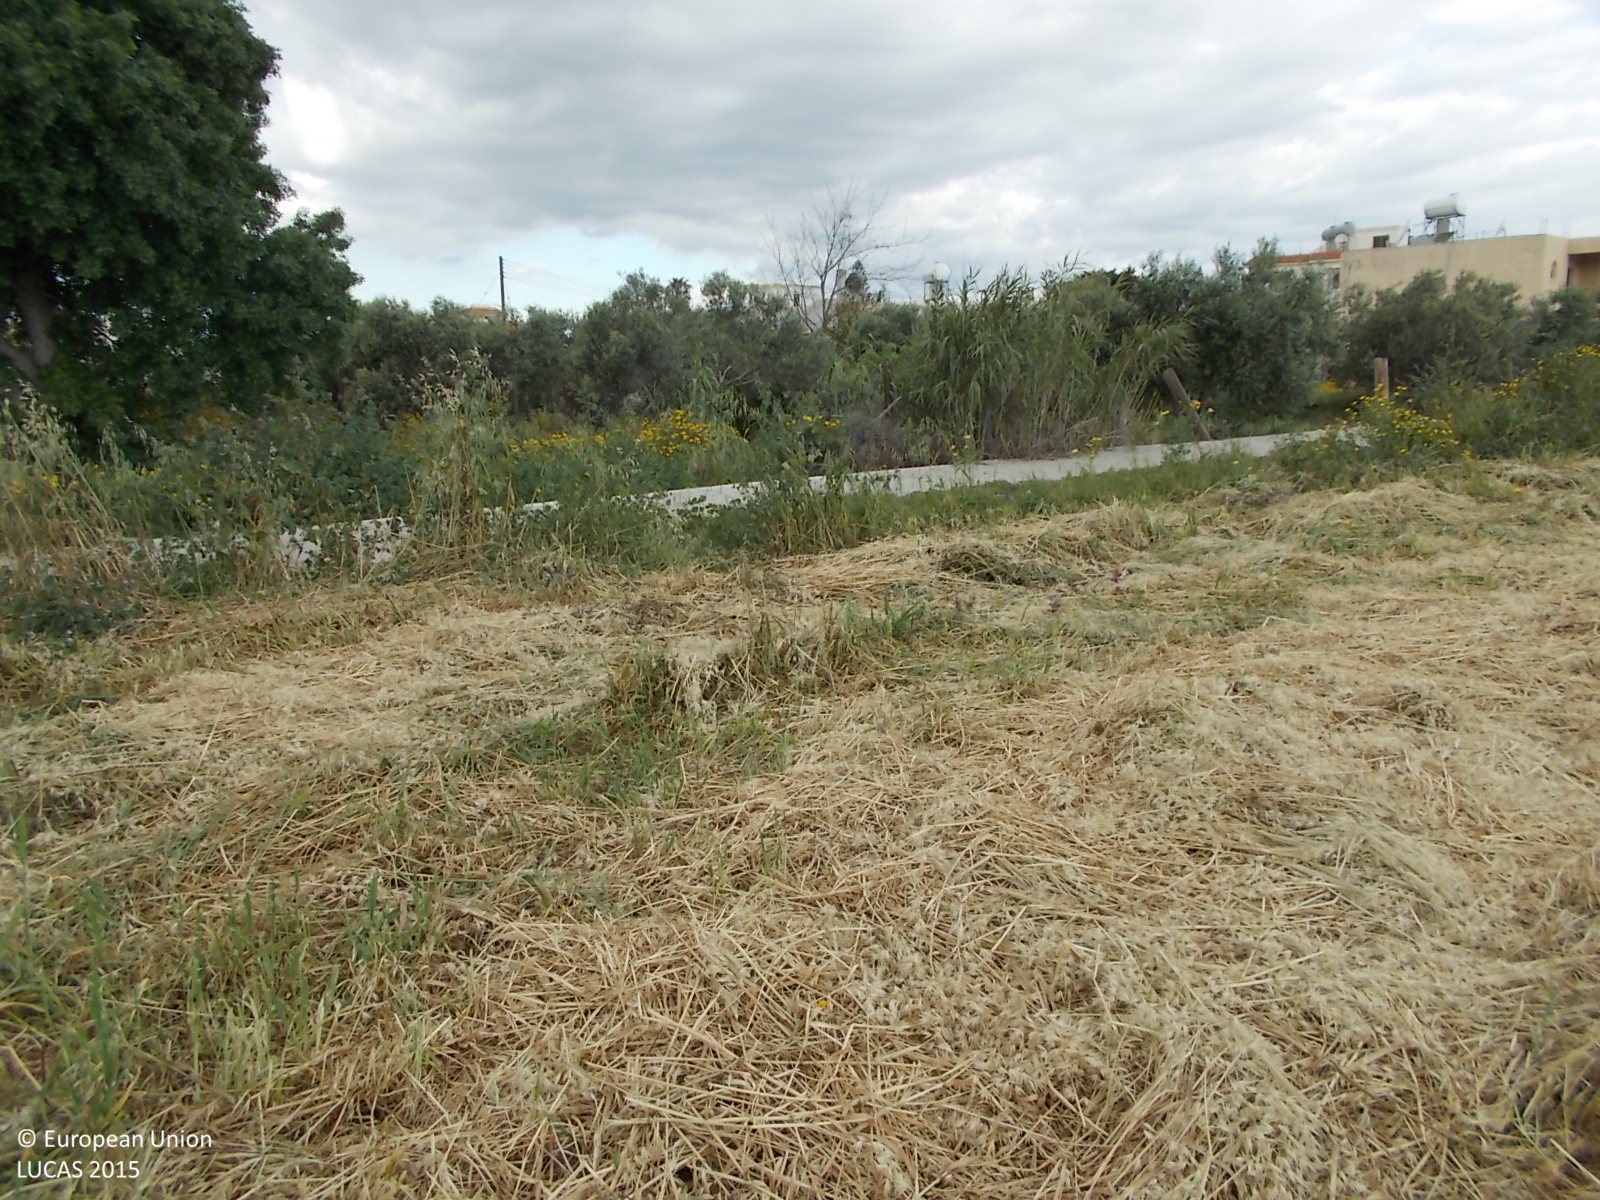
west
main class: Cropland
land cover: Oats
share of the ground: 10 - 25 %
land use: Agriculture (excluding fallow land and kitchen gardens)
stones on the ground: < 10 %
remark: Harvested field
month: April
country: CY
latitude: 34.8314
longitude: 33.5800
